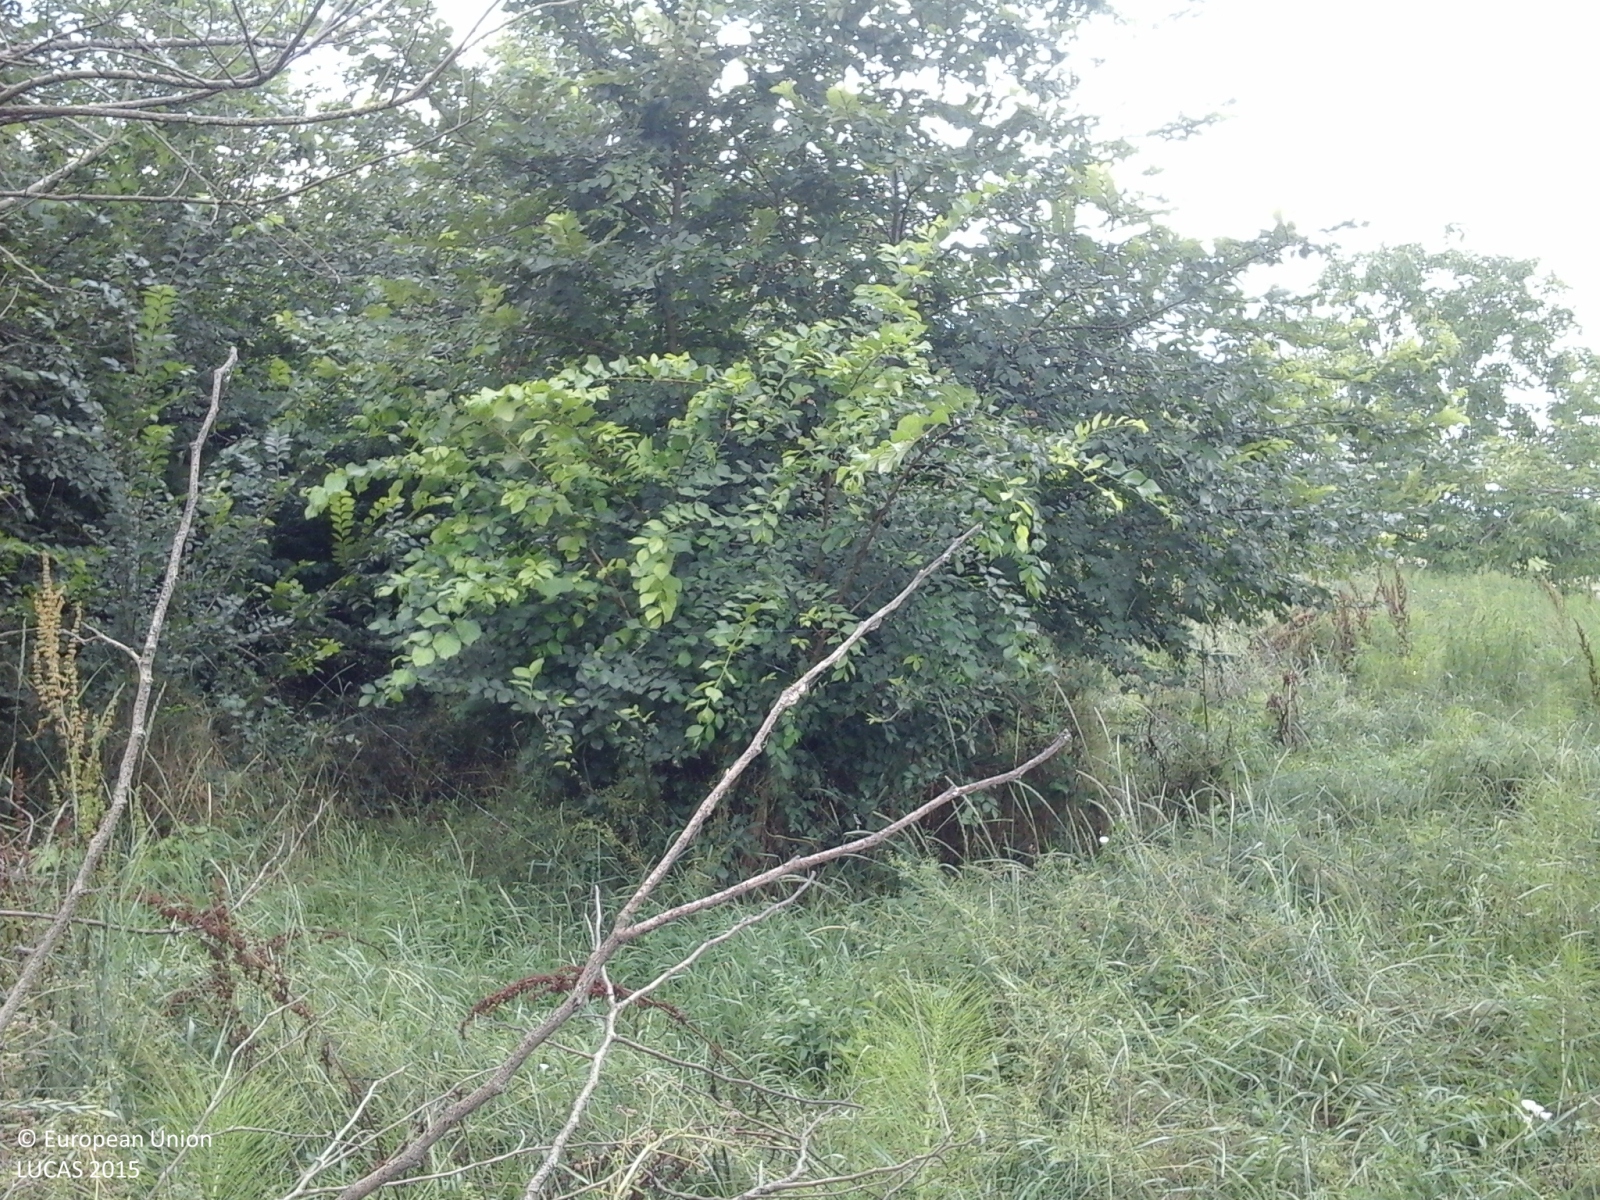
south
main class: Woodland
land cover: Broadleaved woodland
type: thermophilous deciduous forest
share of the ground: > 75 %
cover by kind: broadleaved forest trees 75 %, herbaceous plants 15 %, shrubs 10 %
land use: Semi-natural and natural areas not in use
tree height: > 5 m
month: June
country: IT
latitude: 44.6904
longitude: 10.7681
